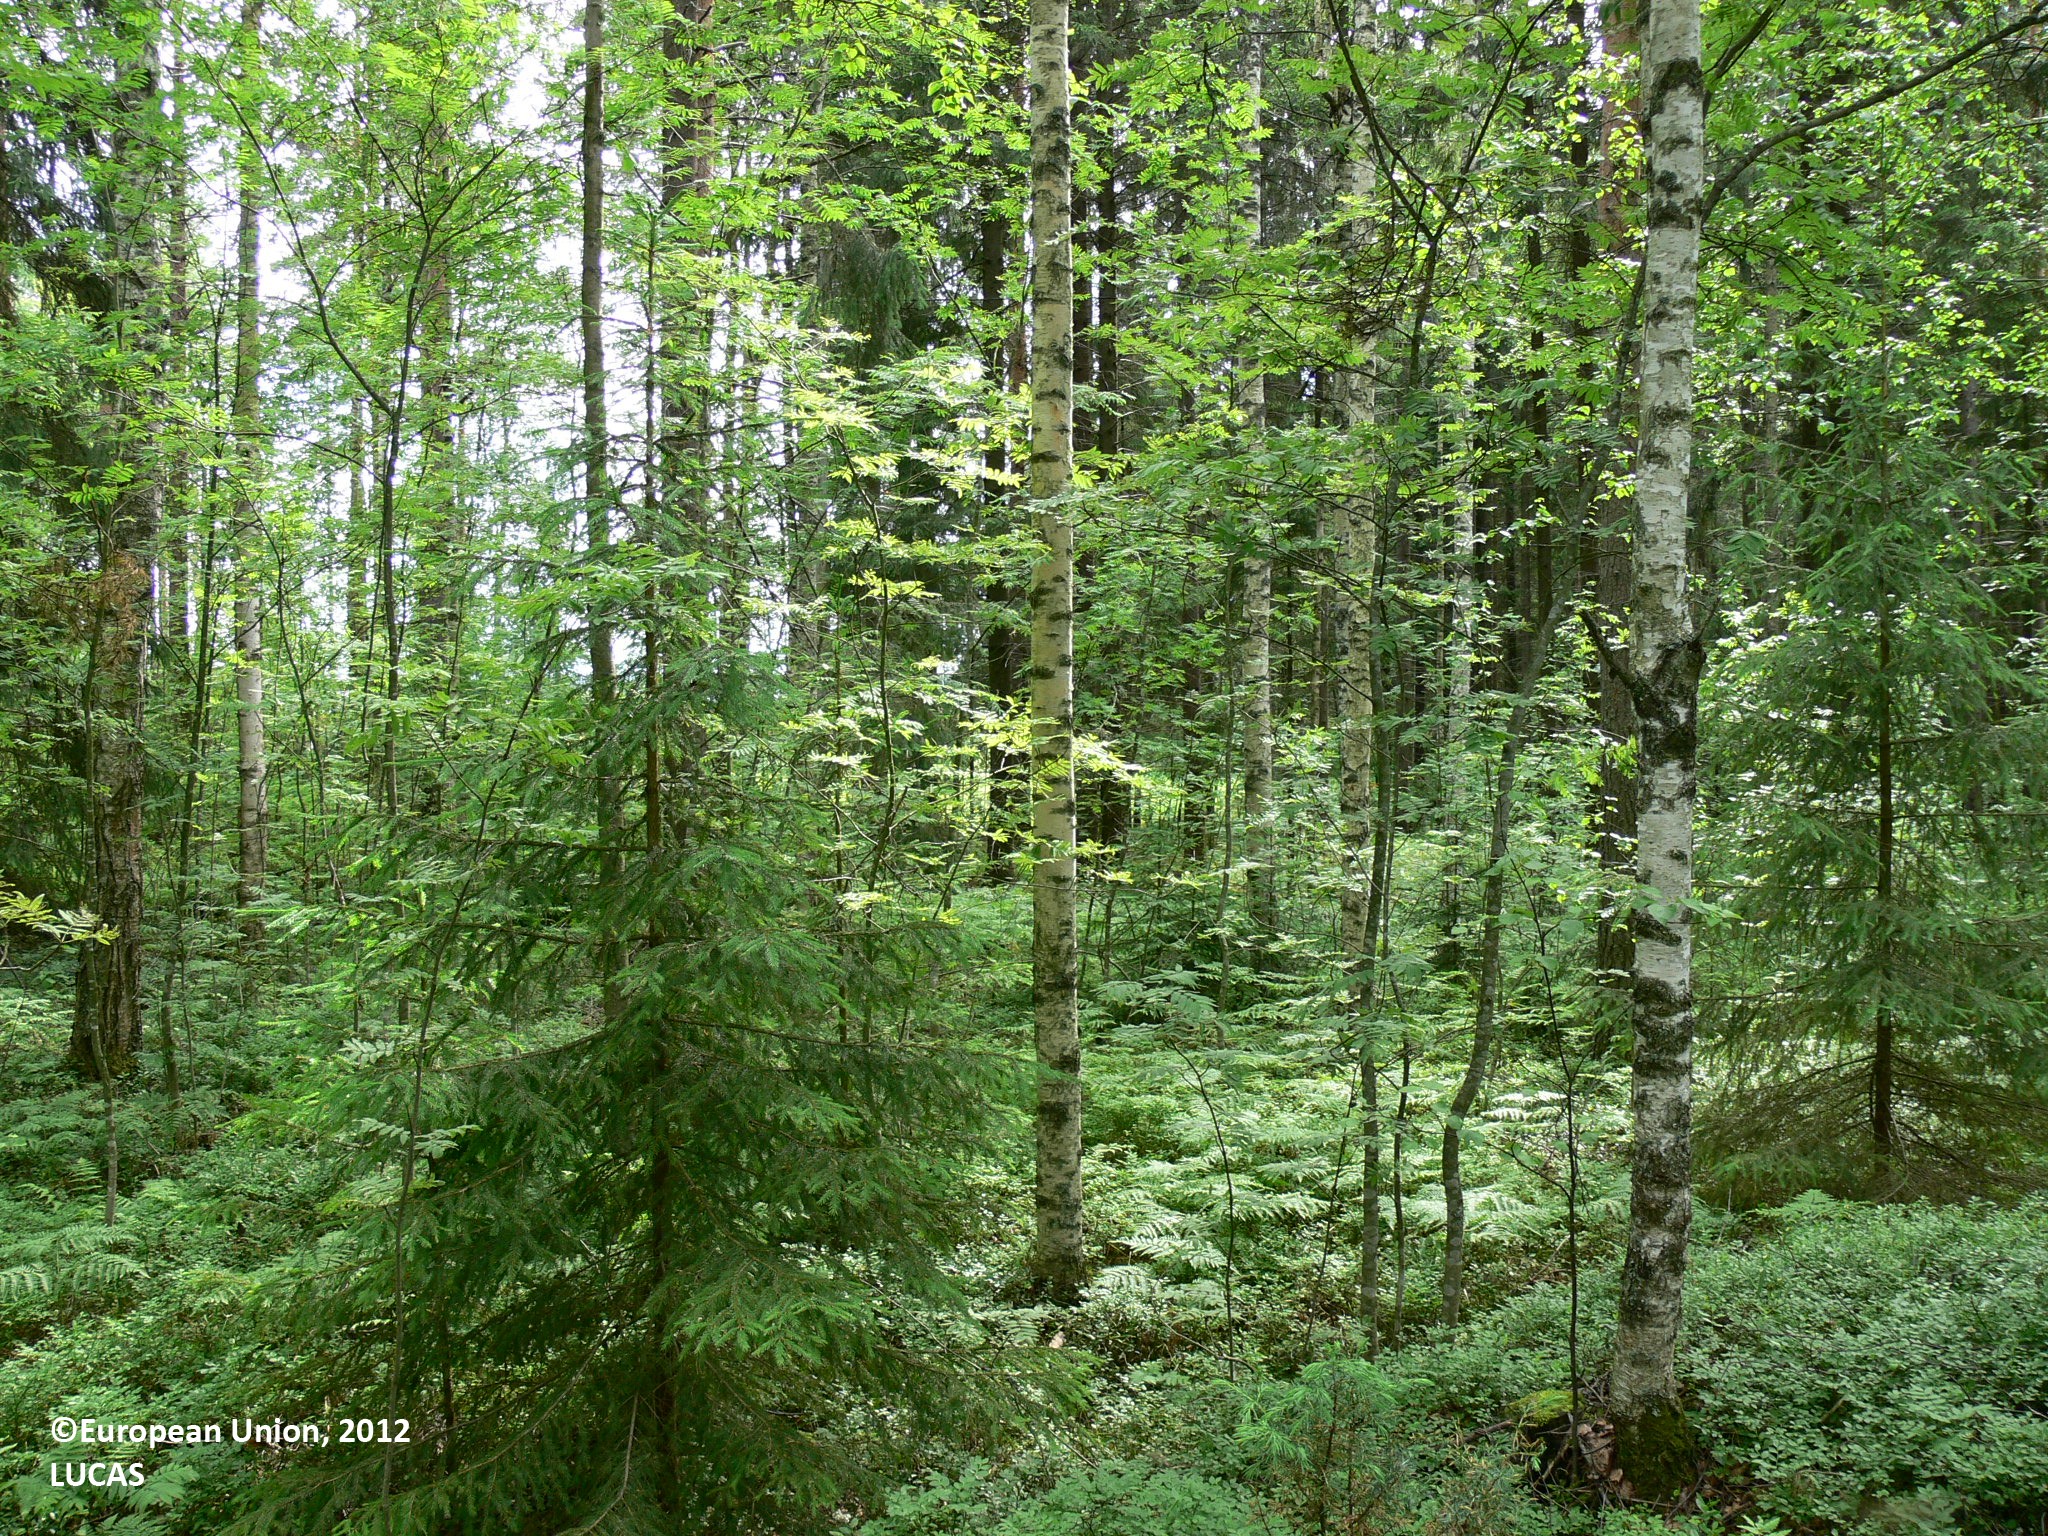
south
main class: Woodland
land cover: Pine dominated mixed woodland
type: boreal forest
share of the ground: > 75 %
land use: Forestry
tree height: > 5 m
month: June
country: FI
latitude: 62.4674
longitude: 29.4146
